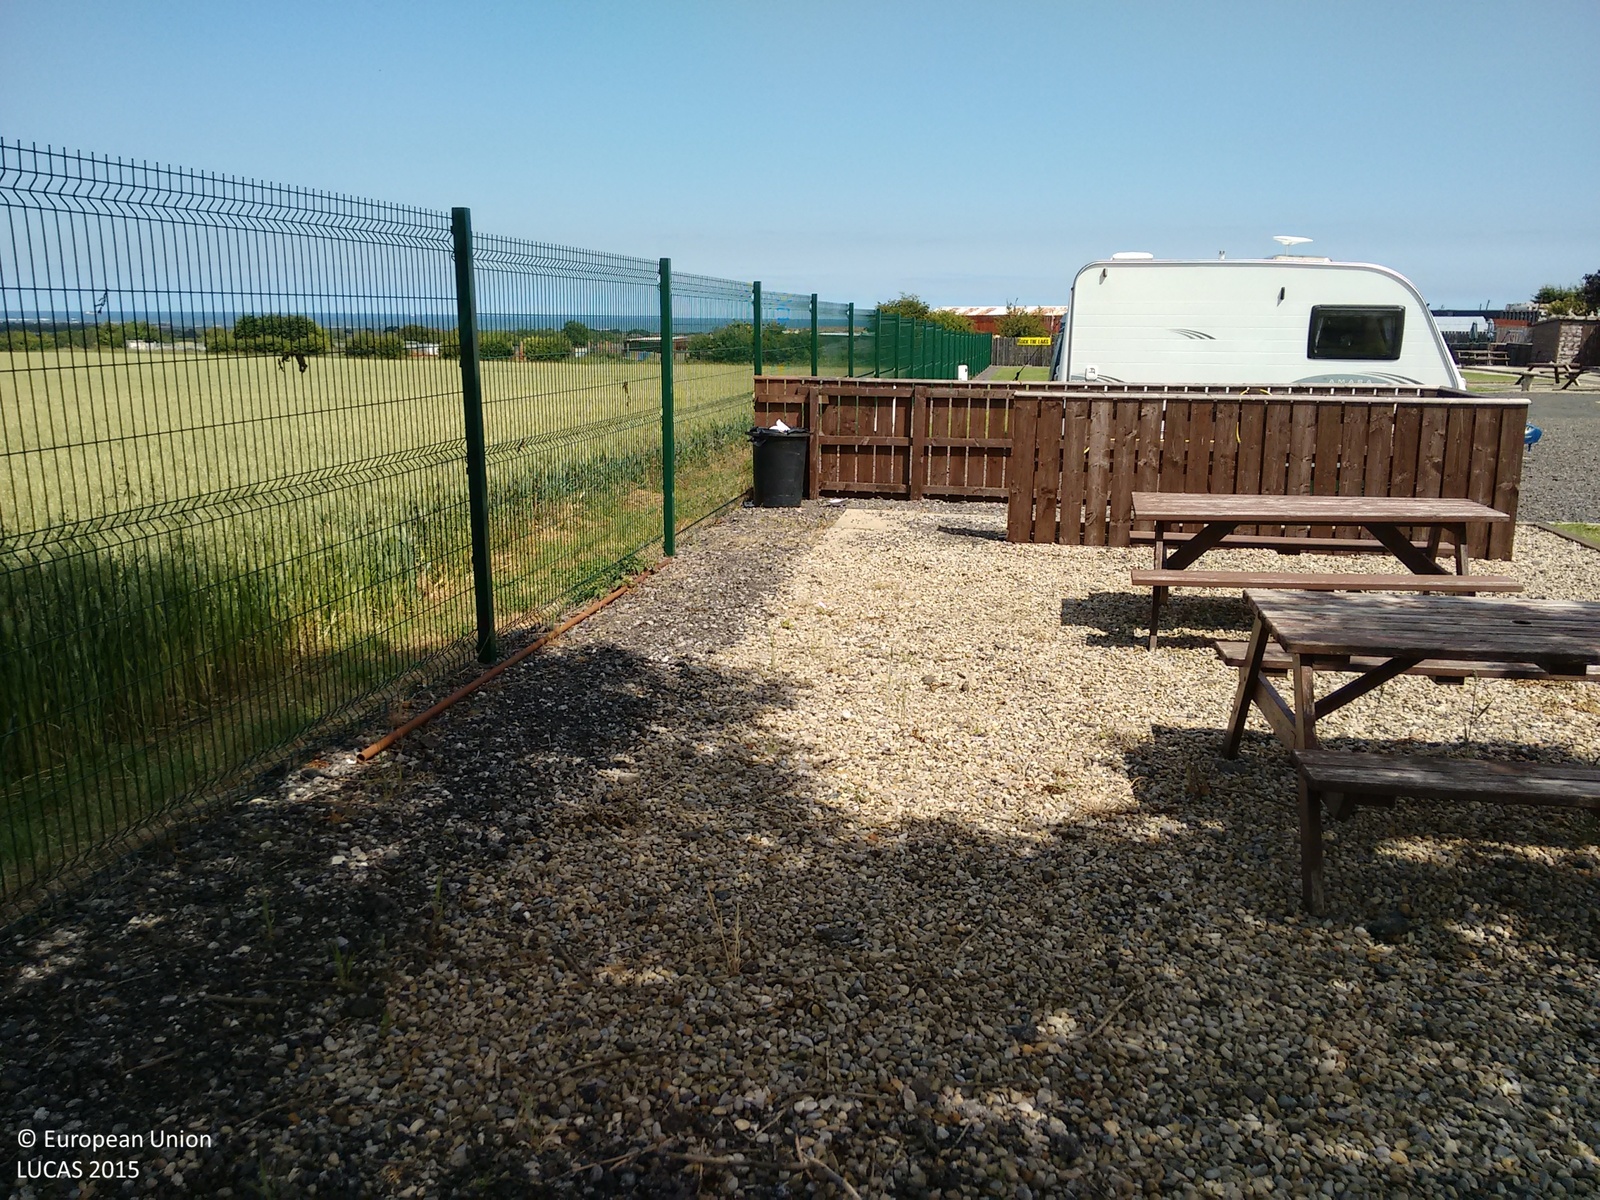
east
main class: Cropland
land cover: Common wheat
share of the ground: > 75 %
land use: Agriculture (excluding fallow land and kitchen gardens)
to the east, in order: Common wheat; Fences; Managed hedges; Artificial constructions in urban areas
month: July
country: GB
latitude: 54.5836
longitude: -1.0434
